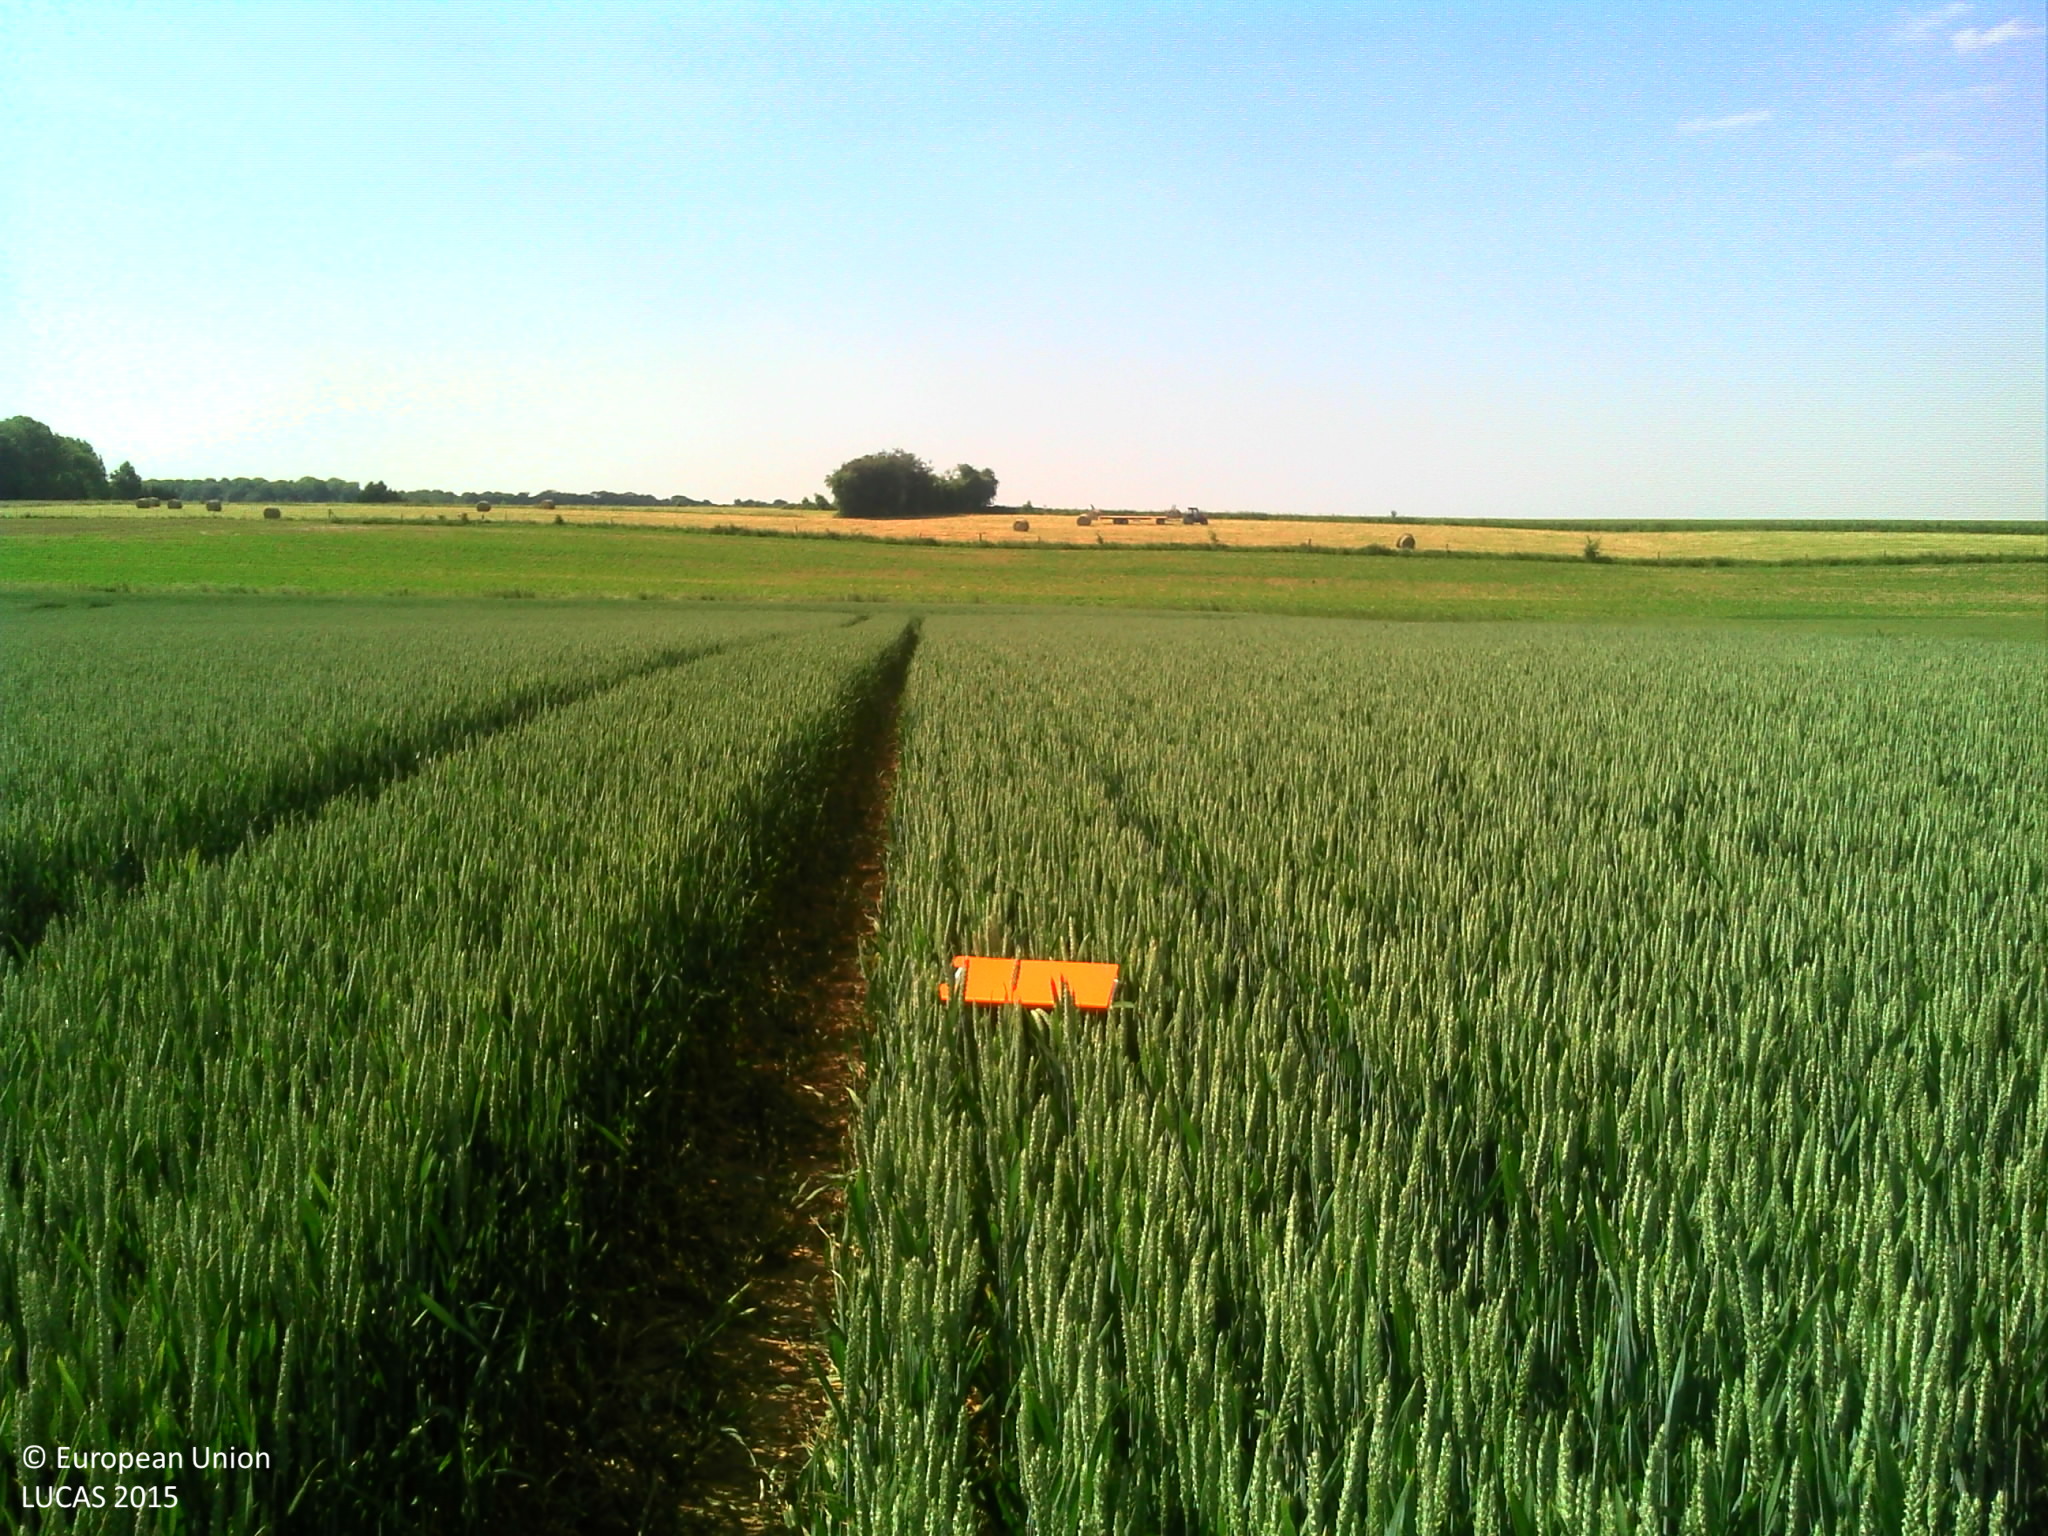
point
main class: Cropland
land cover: Common wheat
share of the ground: > 75 %
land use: Agriculture (excluding fallow land and kitchen gardens)
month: June
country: FR
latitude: 49.7564
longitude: 4.0119
